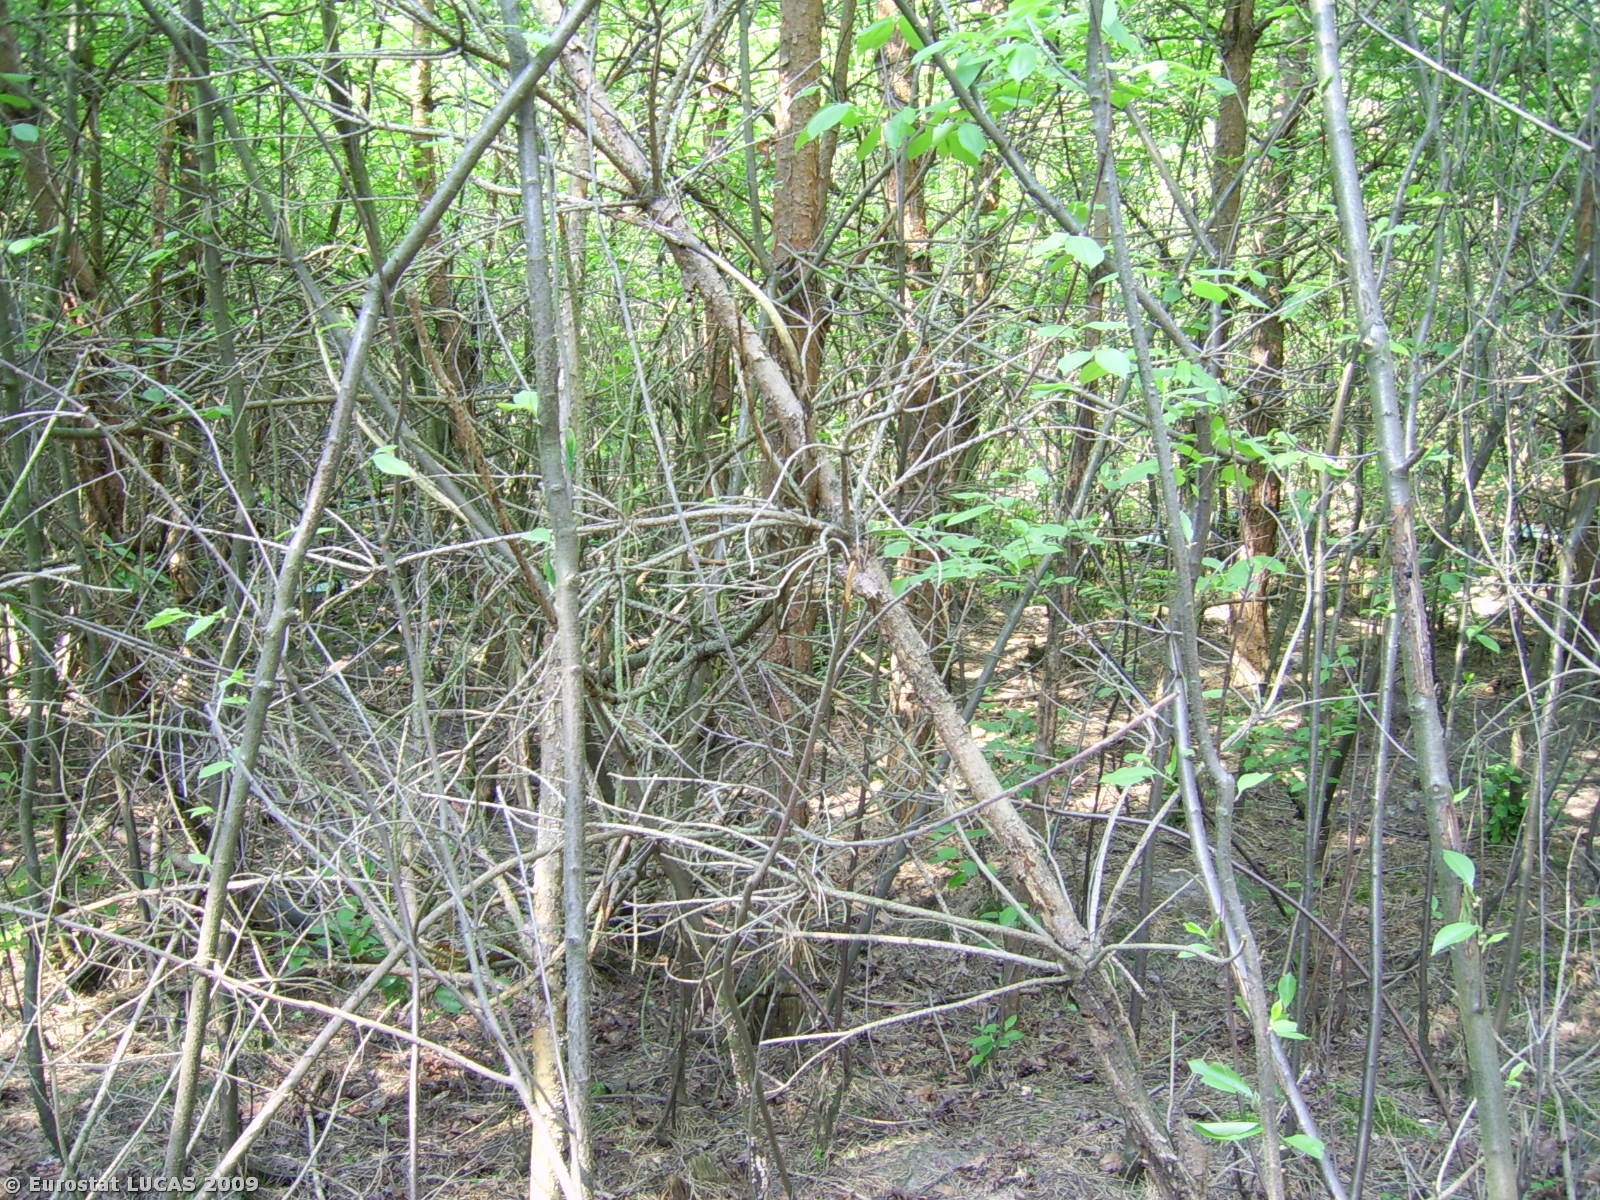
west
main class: Woodland
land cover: Mixed woodland
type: hemiboreal forest and nemoral coniferous forest and mixed broadleaved-coniferous forest
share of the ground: > 75 %
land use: Forestry
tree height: > 5 m
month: April
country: PL
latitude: 52.0500
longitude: 16.9068
